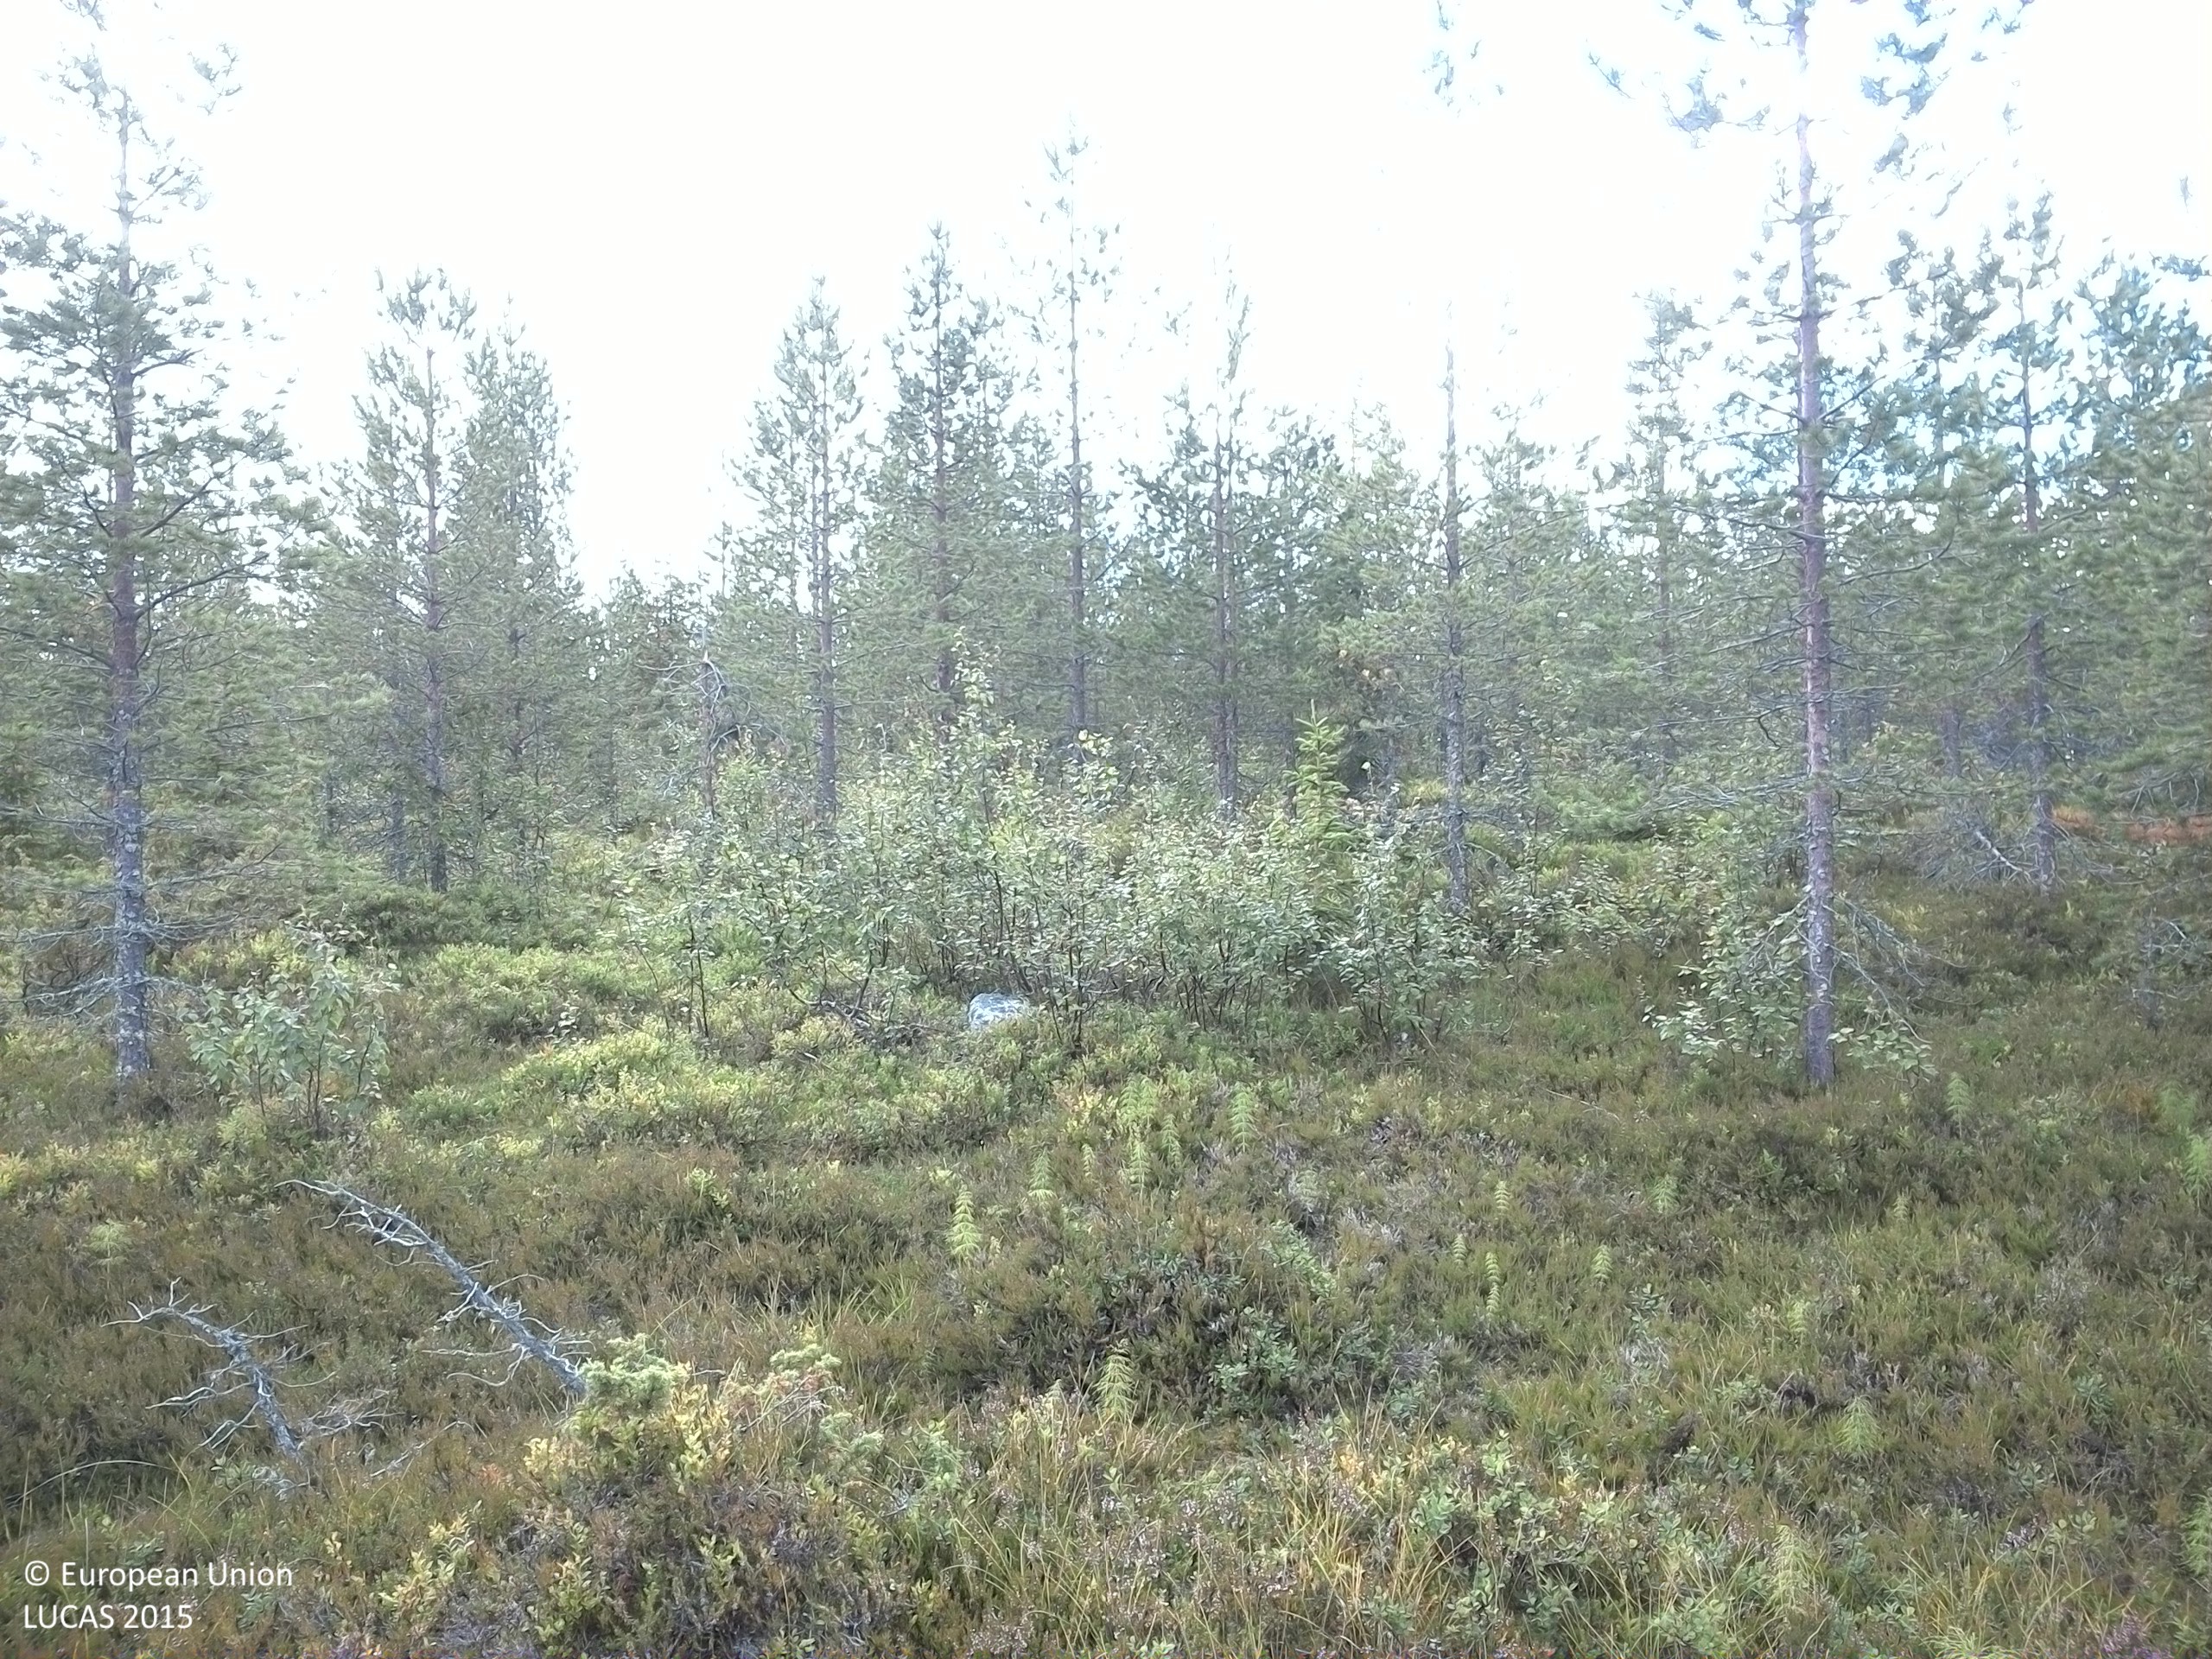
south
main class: Woodland
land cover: Pine dominated coniferous woodland
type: boreal forest
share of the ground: 25 - 50 %
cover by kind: shrubs 65 %, coniferous forest trees 25 %, broadleaved forest trees 5 %, lichens and mosses 5 %
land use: Forestry
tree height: < 5 m
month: August
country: SE
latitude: 63.7573
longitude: 18.0609
